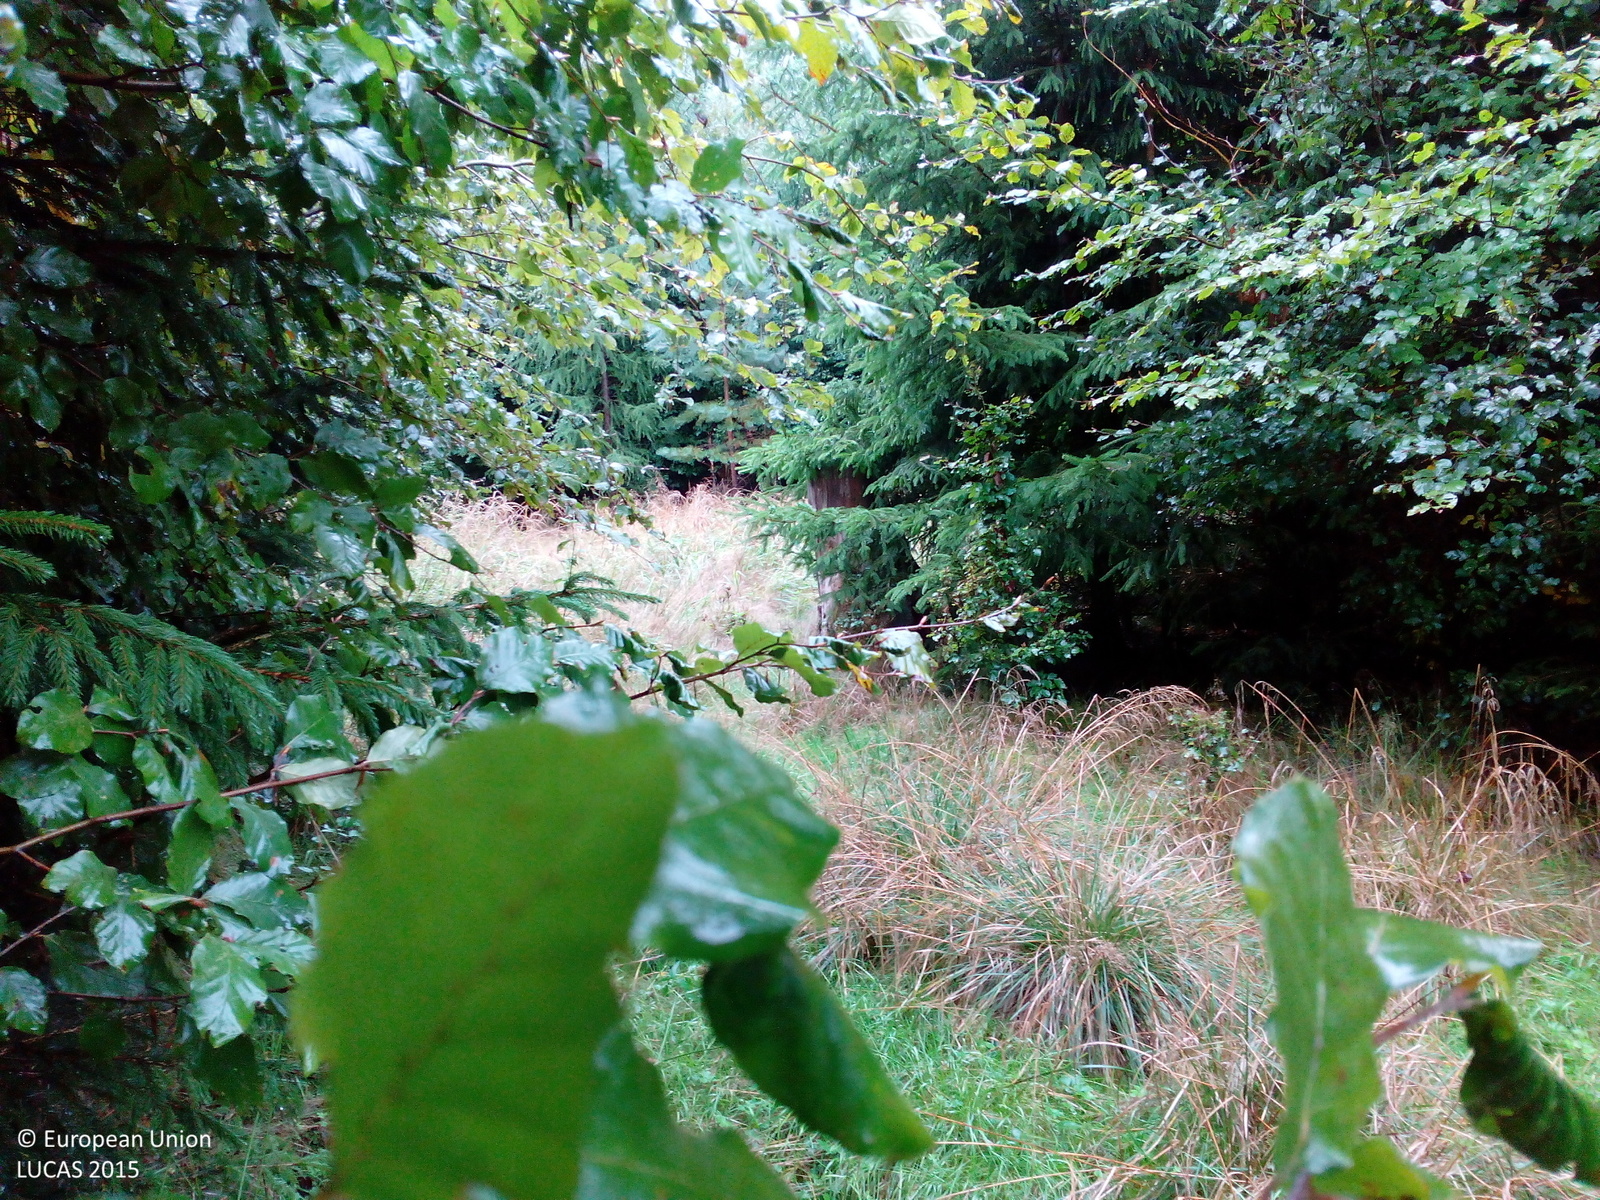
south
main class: Woodland
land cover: Spruce dominated mixed woodland
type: hemiboreal forest and nemoral coniferous forest and mixed broadleaved-coniferous forest
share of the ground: > 75 %
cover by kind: coniferous forest trees 60 %, broadleaved forest trees 40 %
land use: Forestry
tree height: < 5 m
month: September
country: DE
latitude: 49.9318
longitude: 9.5961
